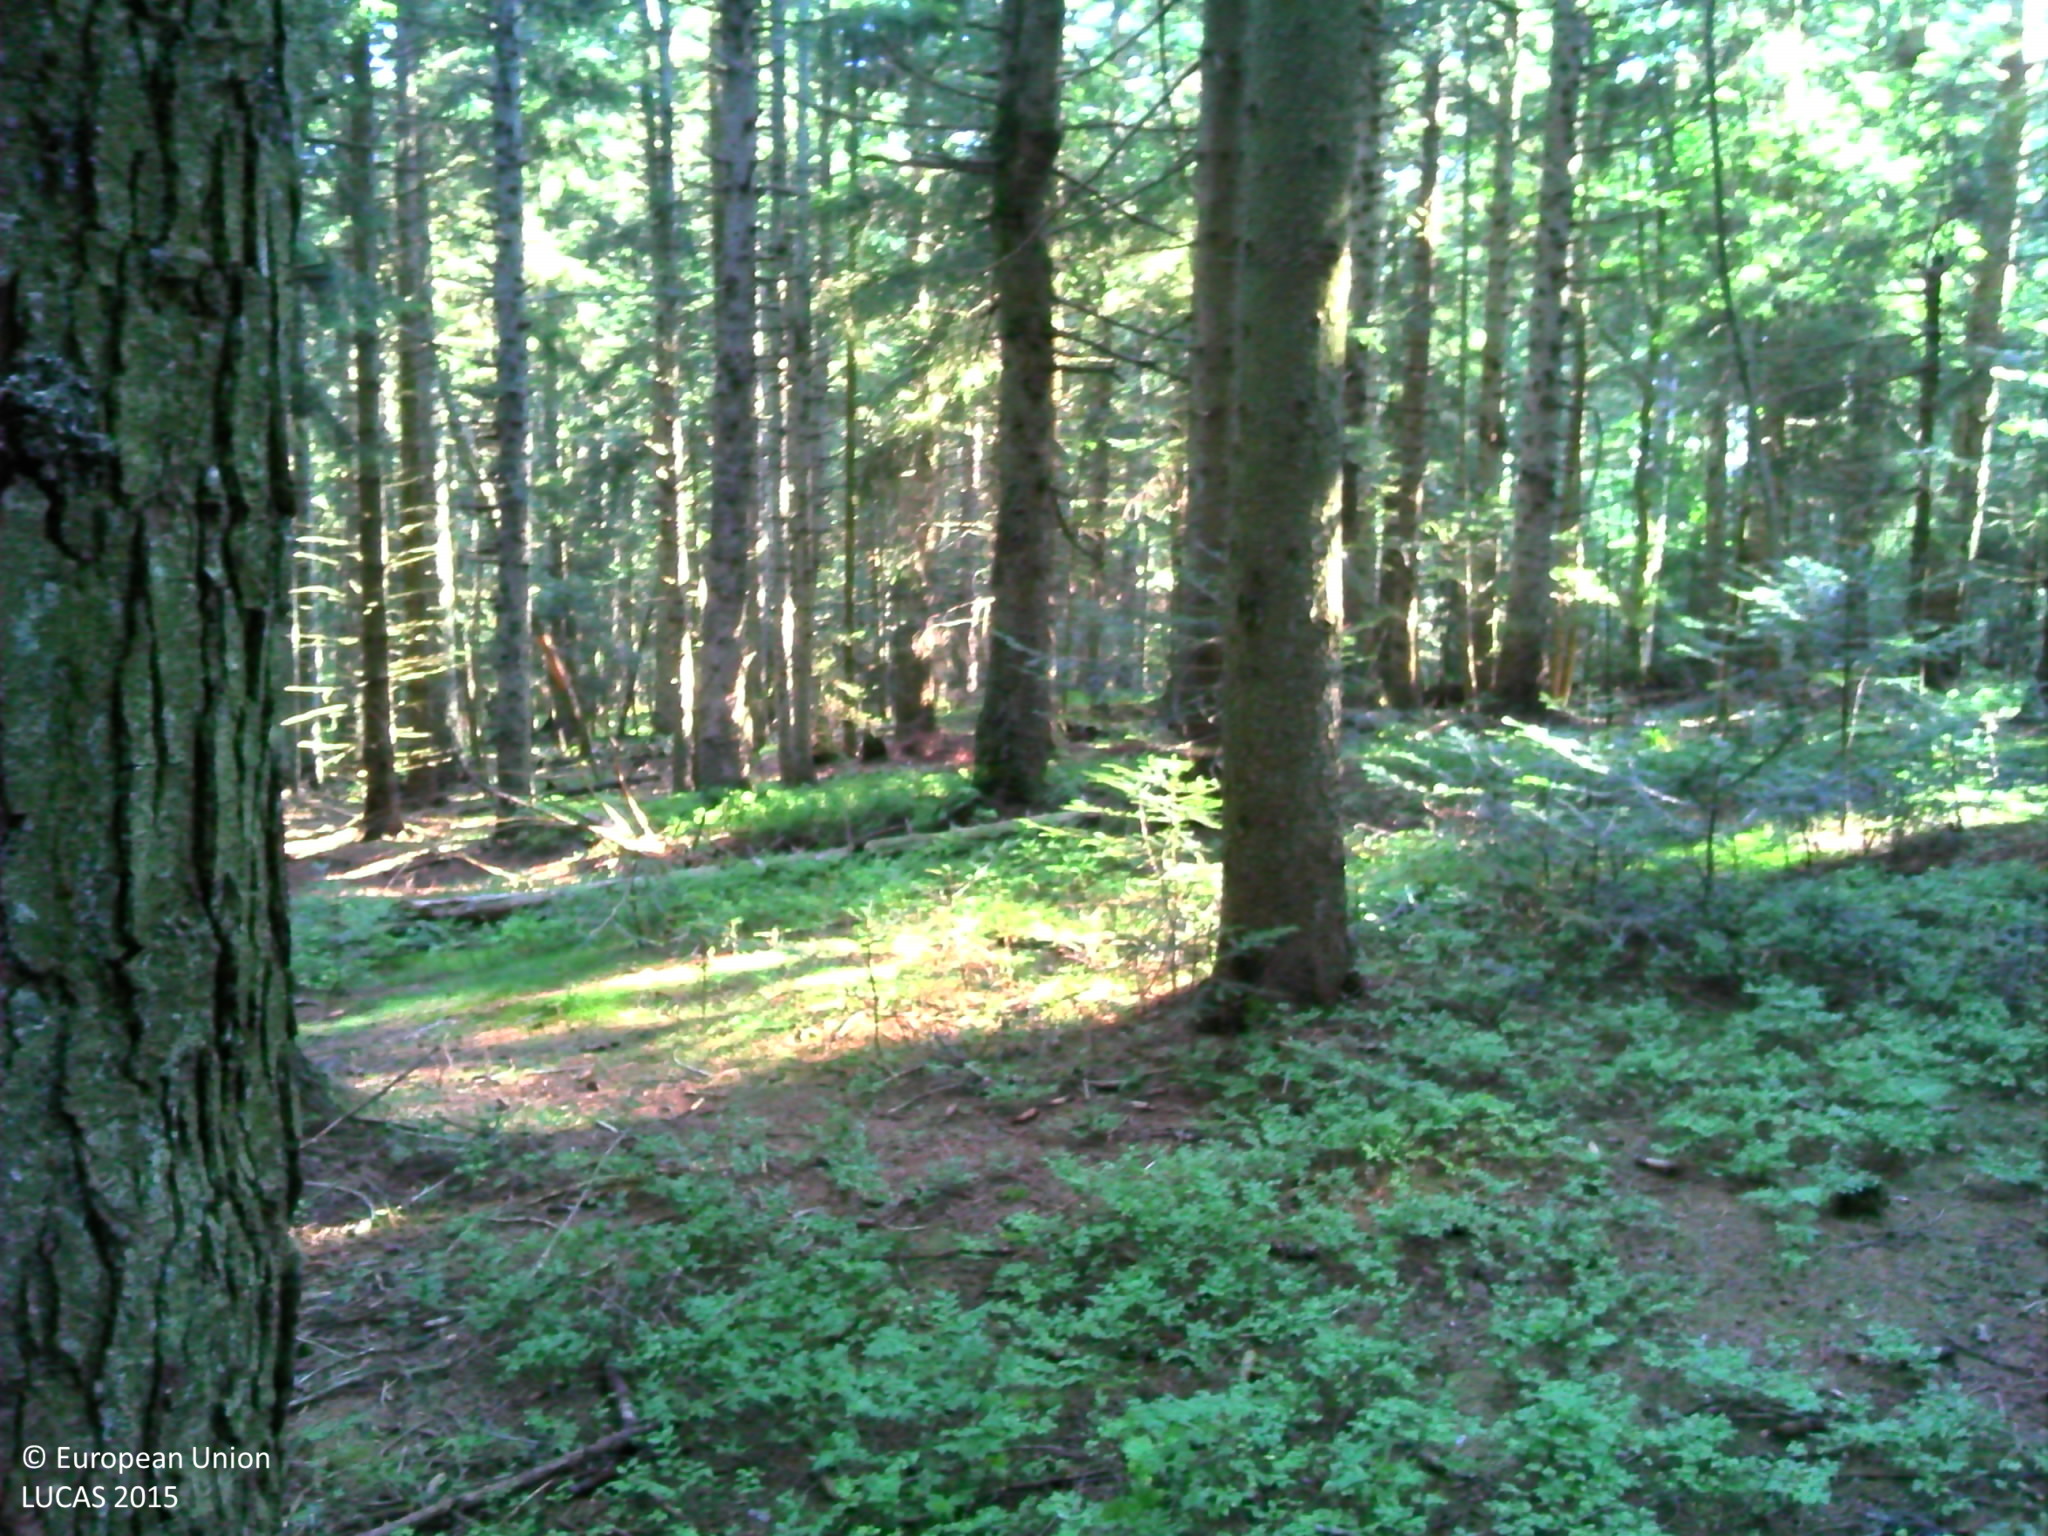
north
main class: Woodland
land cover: Spruce dominated coniferous woodland
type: alpine coniferous forest
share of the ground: > 75 %
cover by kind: coniferous forest trees 65 %, herbaceous plants 20 %, lichens and mosses 10 %, shrubs 5 %
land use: Forestry
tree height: > 5 m
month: August
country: FR
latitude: 45.3625
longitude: 4.5273
